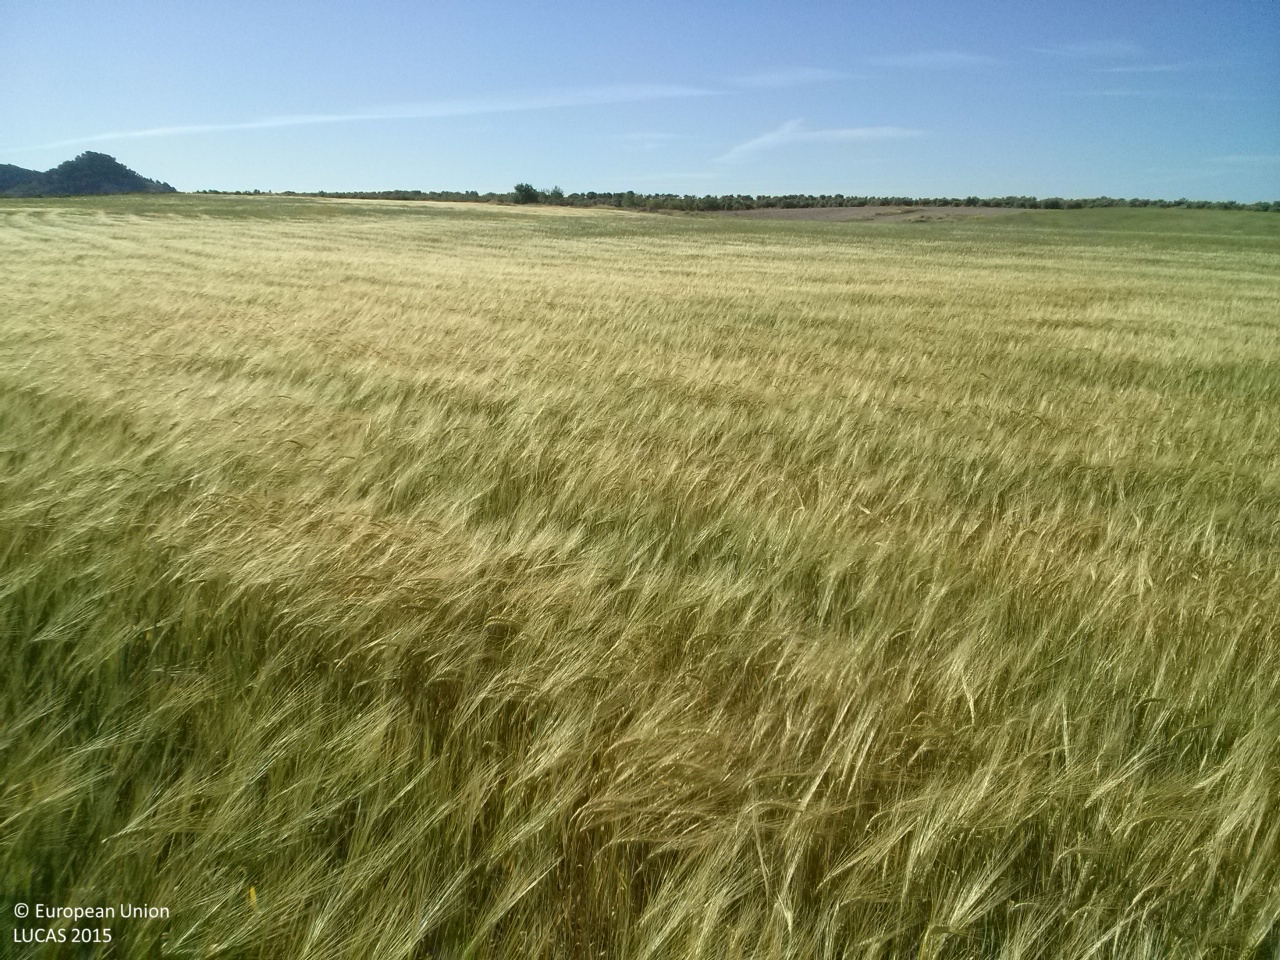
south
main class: Cropland
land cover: Barley
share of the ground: > 75 %
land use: Agriculture (excluding fallow land and kitchen gardens)
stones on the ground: < 10 %
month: May
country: ES
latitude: 40.2988
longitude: -2.5519
